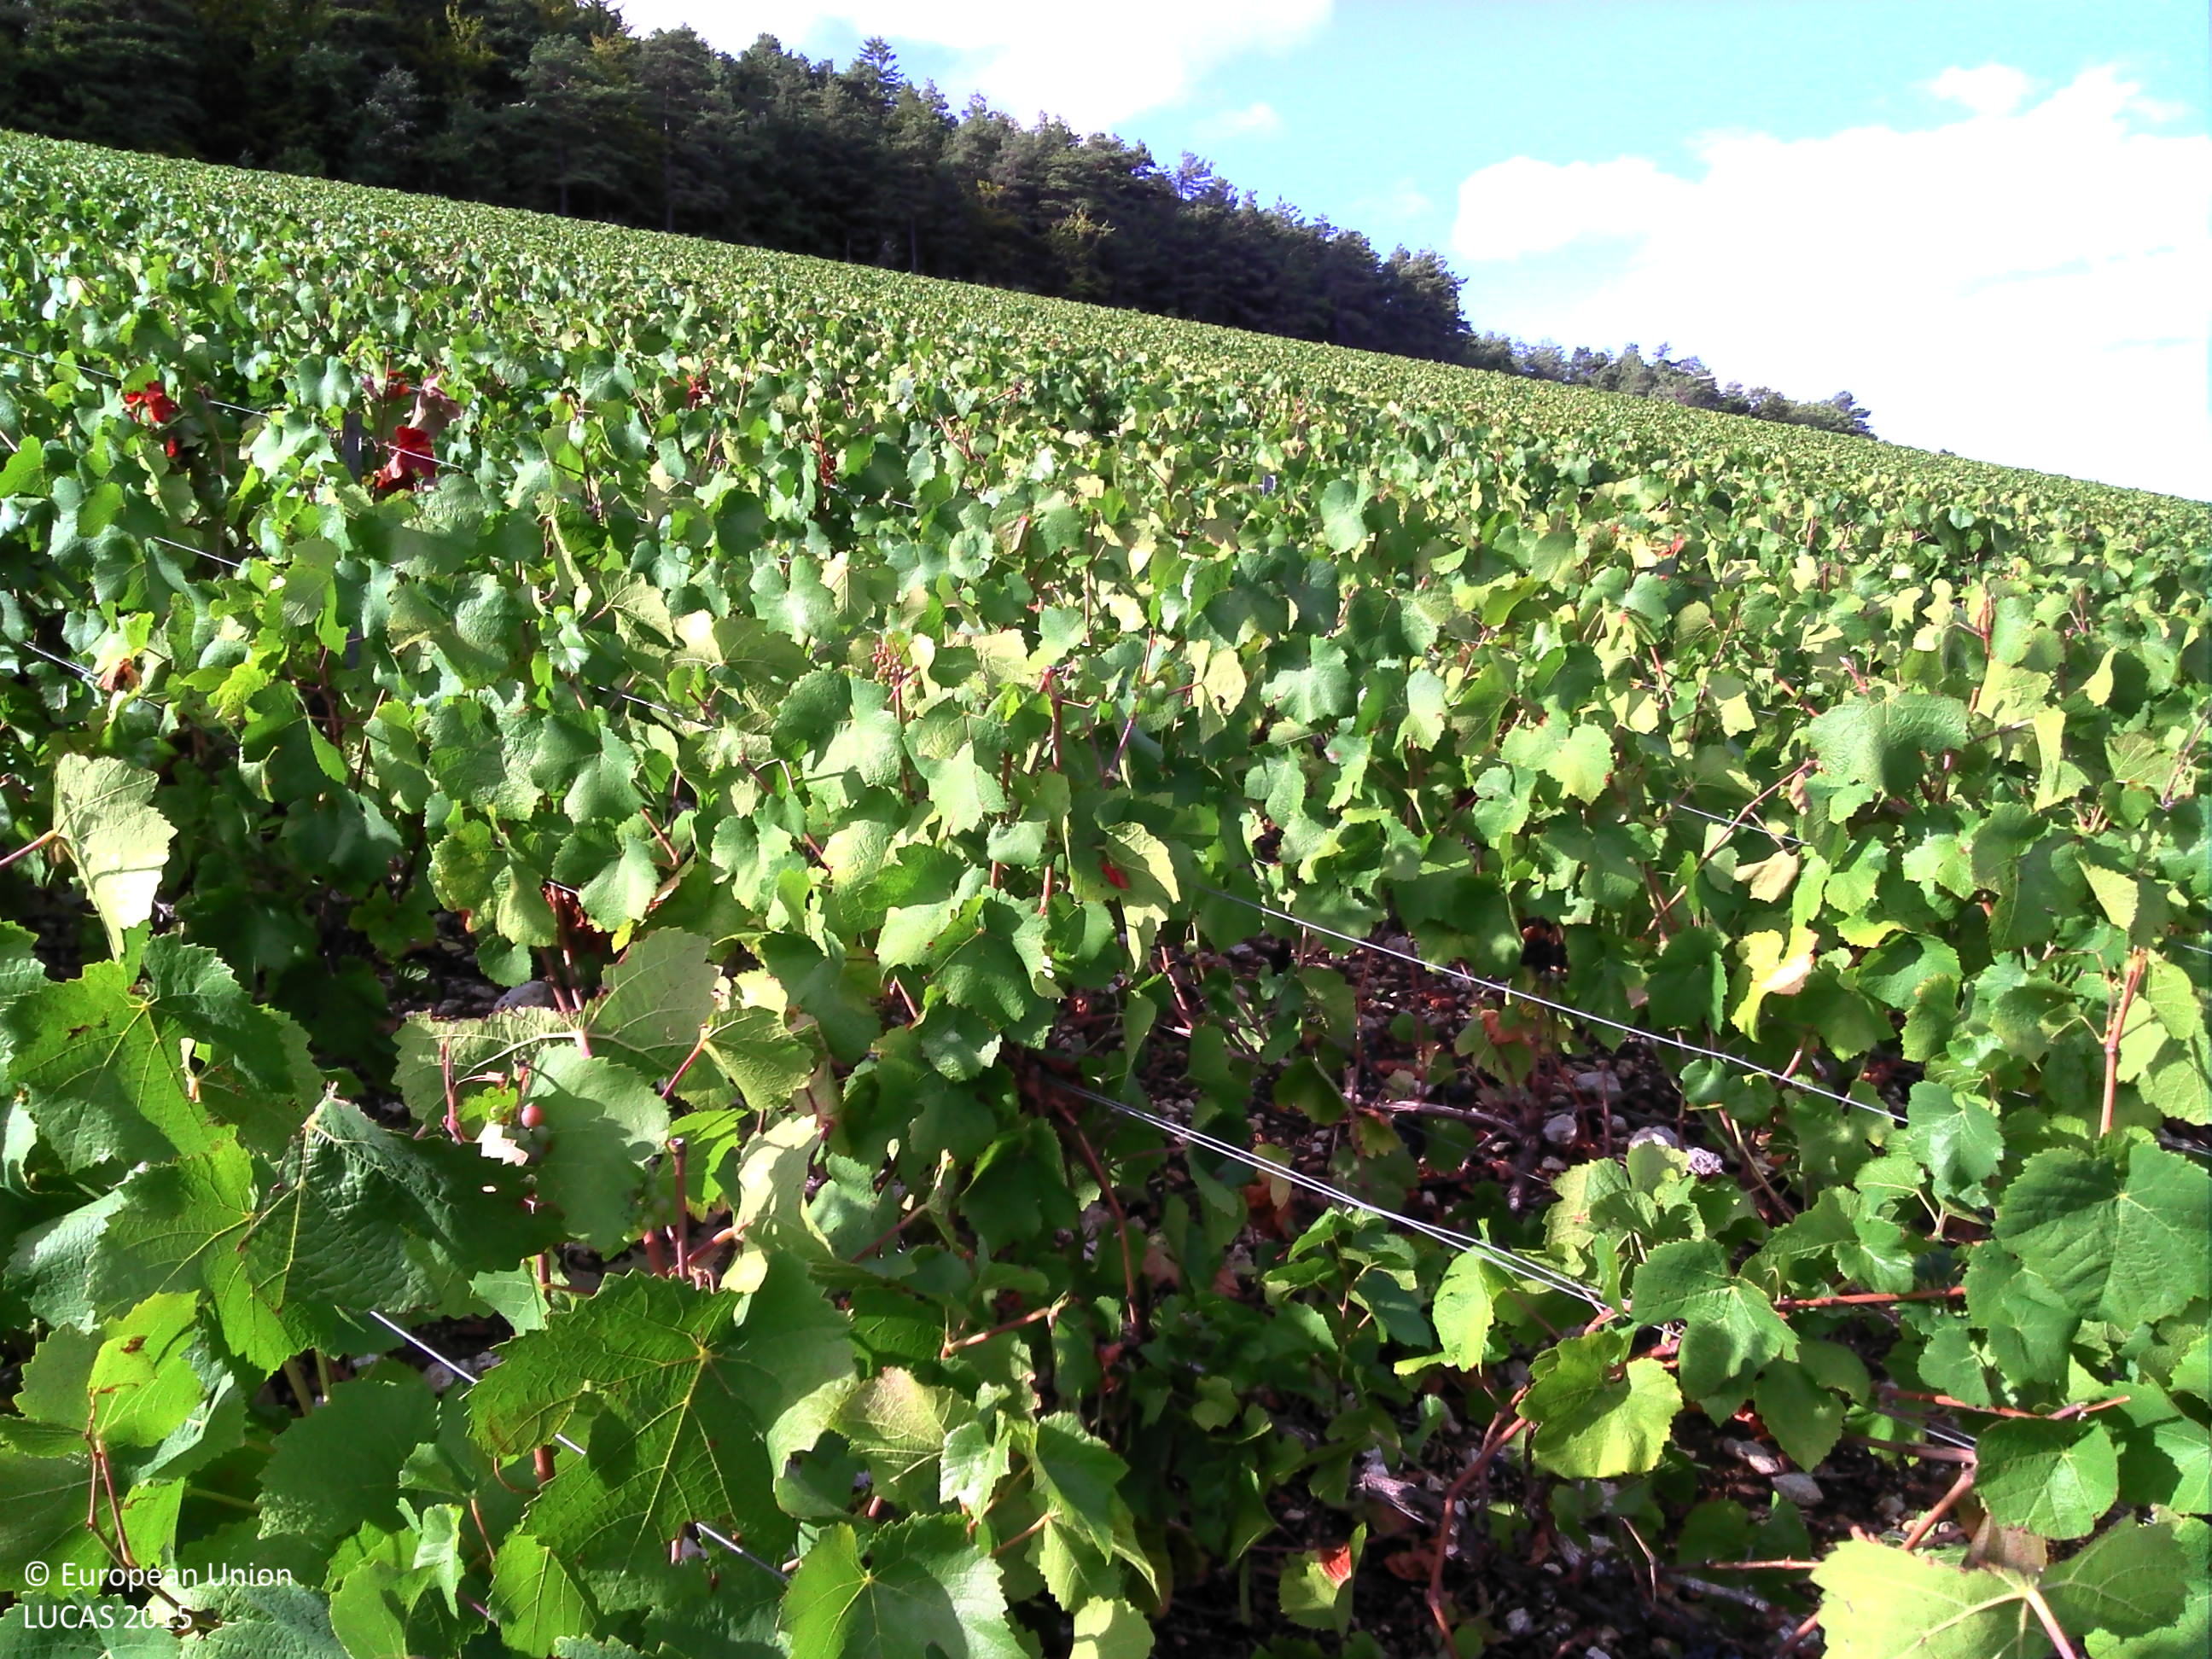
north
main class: Cropland
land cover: Vineyards
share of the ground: 25 - 50 %
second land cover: Other bare soil
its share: > 75 %
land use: Agriculture (excluding fallow land and kitchen gardens)
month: September
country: FR
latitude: 48.1868
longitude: 4.7119
